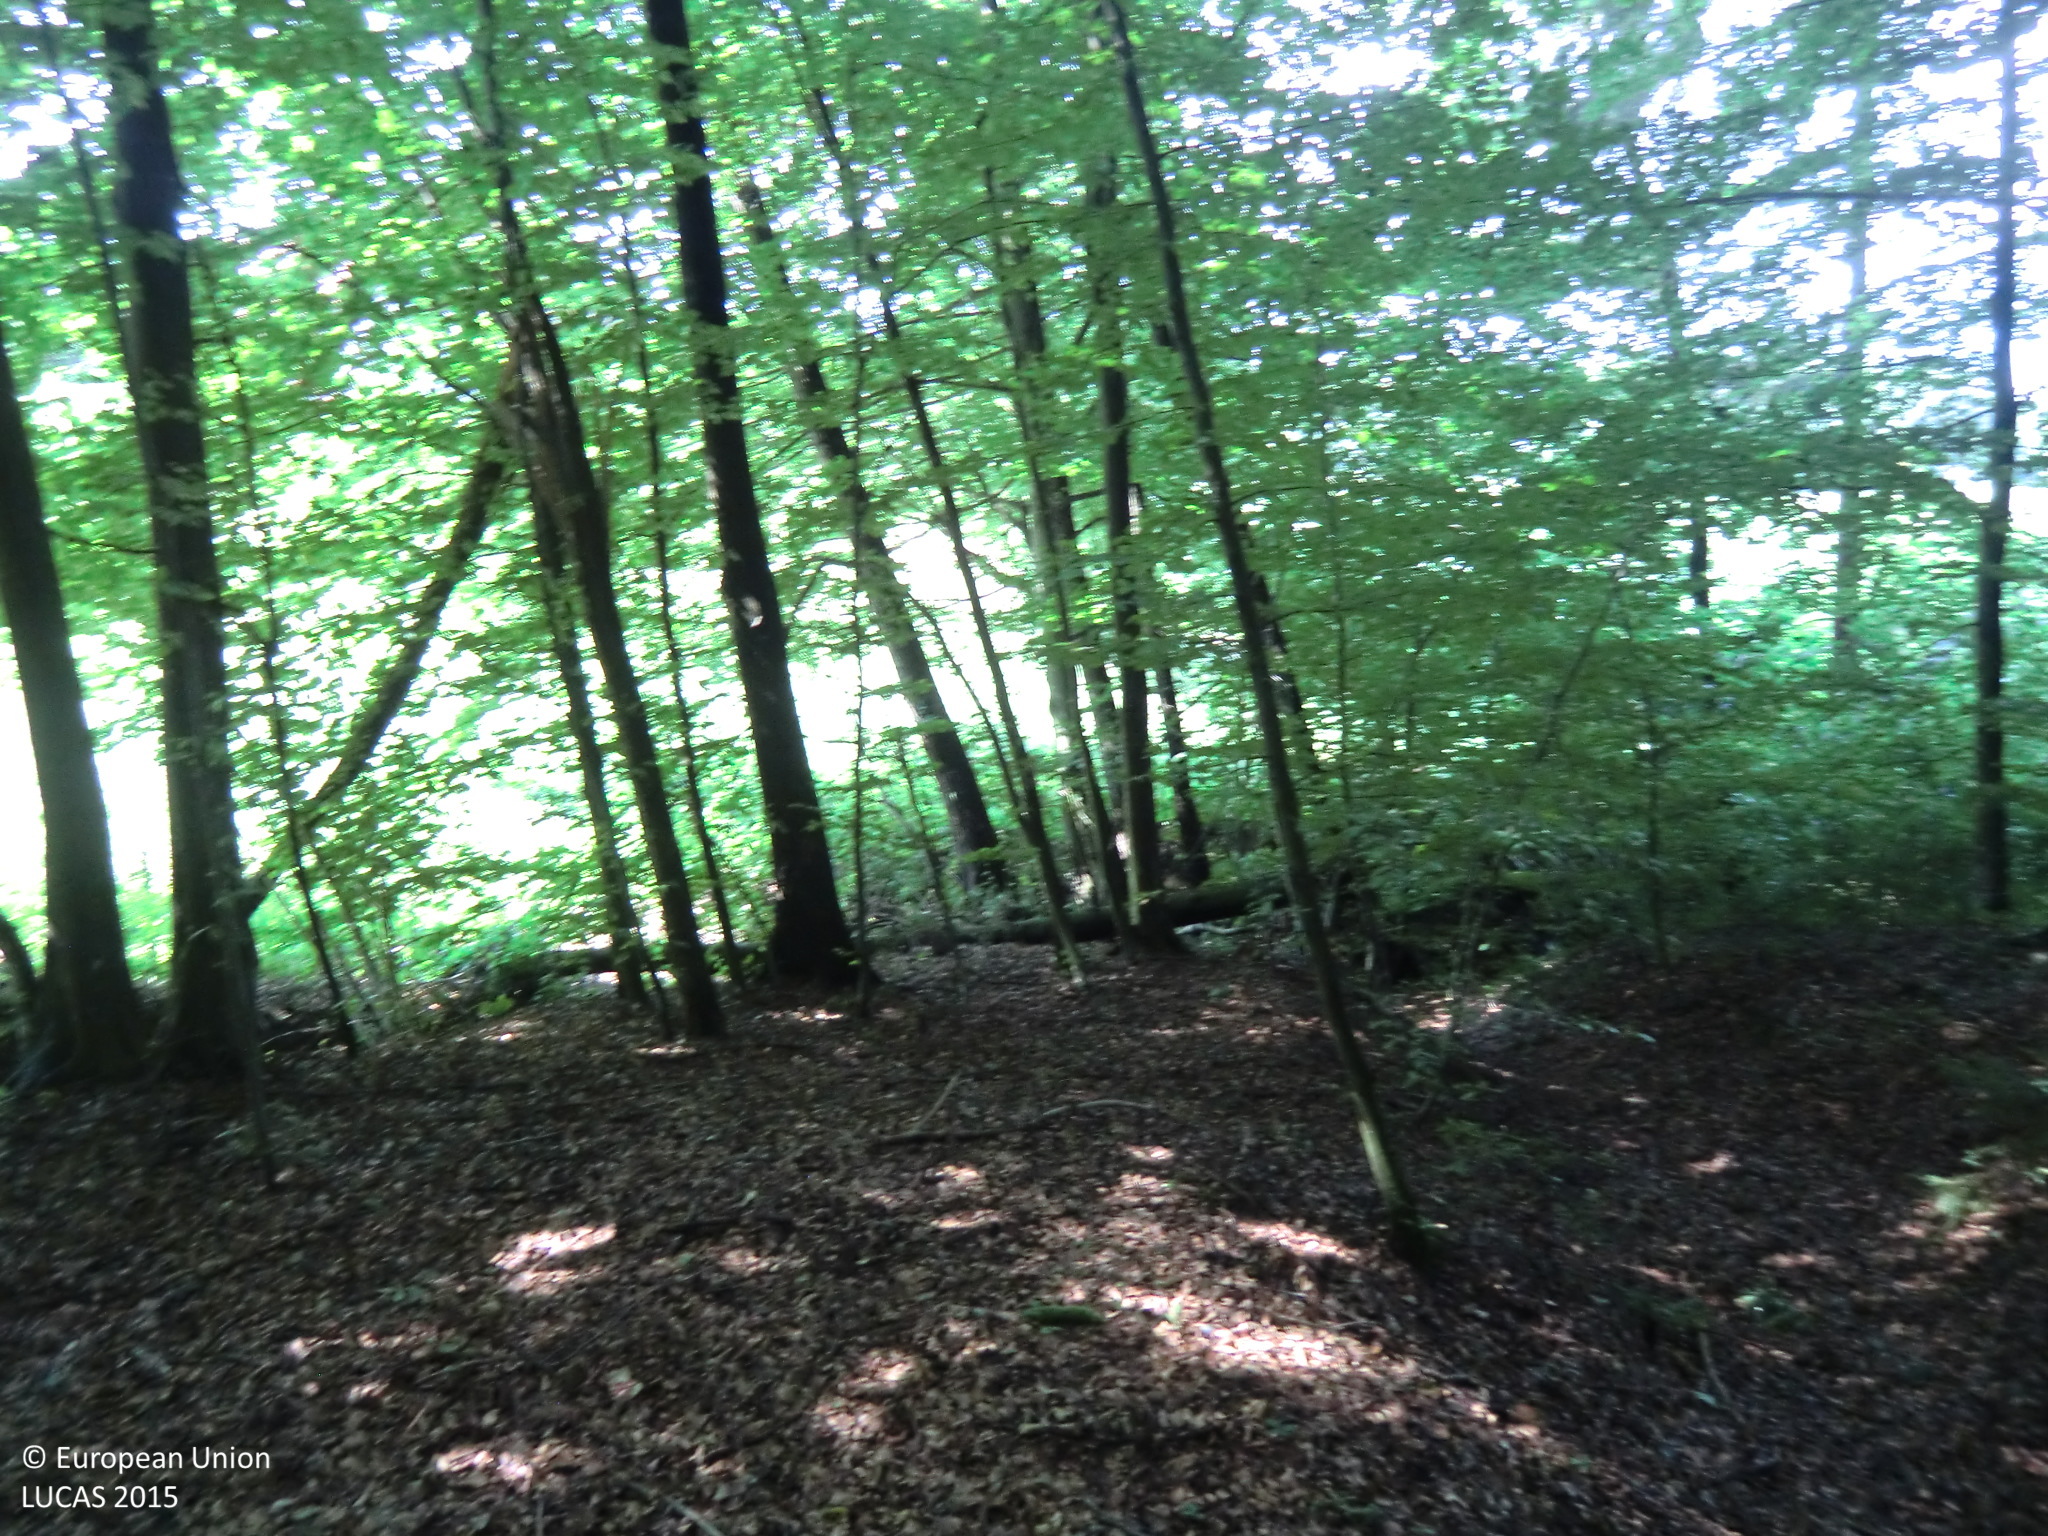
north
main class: Woodland
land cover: Pine dominated mixed woodland
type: hemiboreal forest and nemoral coniferous forest and mixed broadleaved-coniferous forest
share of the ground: > 75 %
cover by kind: broadleaved forest trees 60 %, coniferous forest trees 25 %, unconsolidated bare surface 10 %, herbaceous plants 5 %
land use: Forestry
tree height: > 5 m
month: July
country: AT
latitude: 47.0283
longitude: 15.7241
